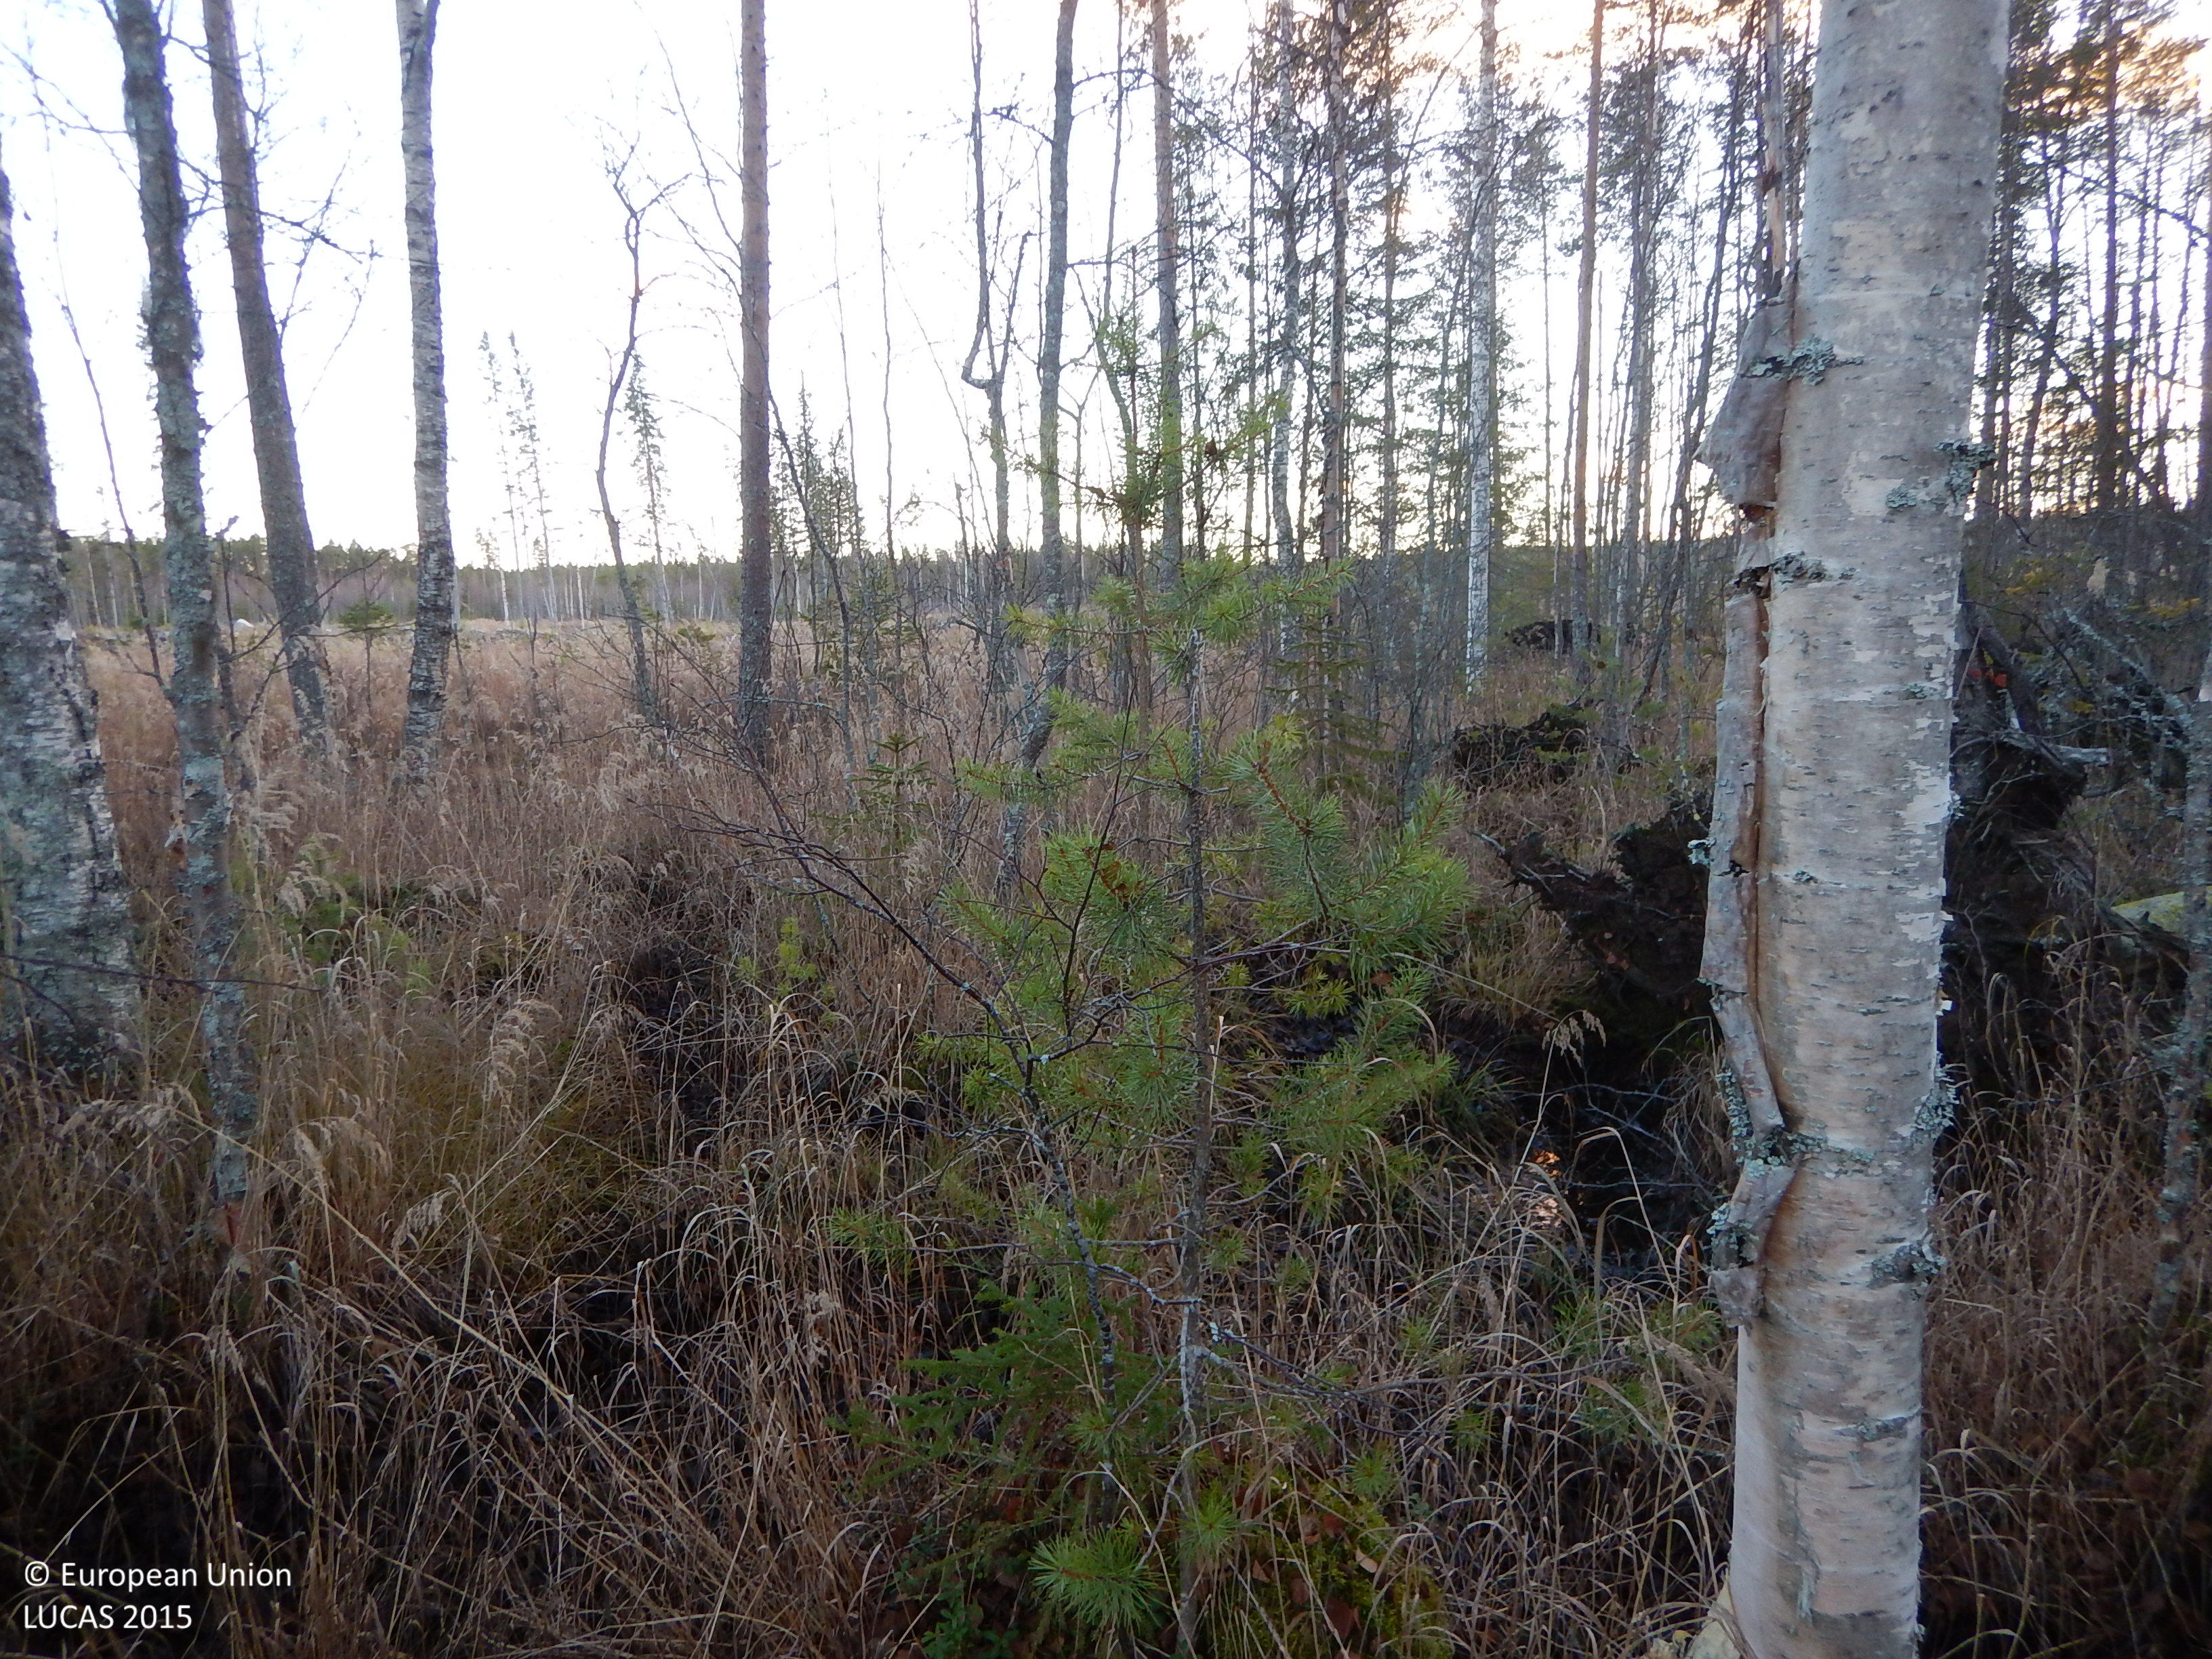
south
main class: Woodland
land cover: Broadleaved woodland
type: mire and swamp forests
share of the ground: 50 - 75 %
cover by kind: broadleaved forest trees 50 %, herbaceous plants 25 %, shrubs 10 %, lichens and mosses 10 %, coniferous forest trees 5 %
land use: Forestry
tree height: > 5 m
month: November
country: SE
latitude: 65.3409
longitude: 21.1215
